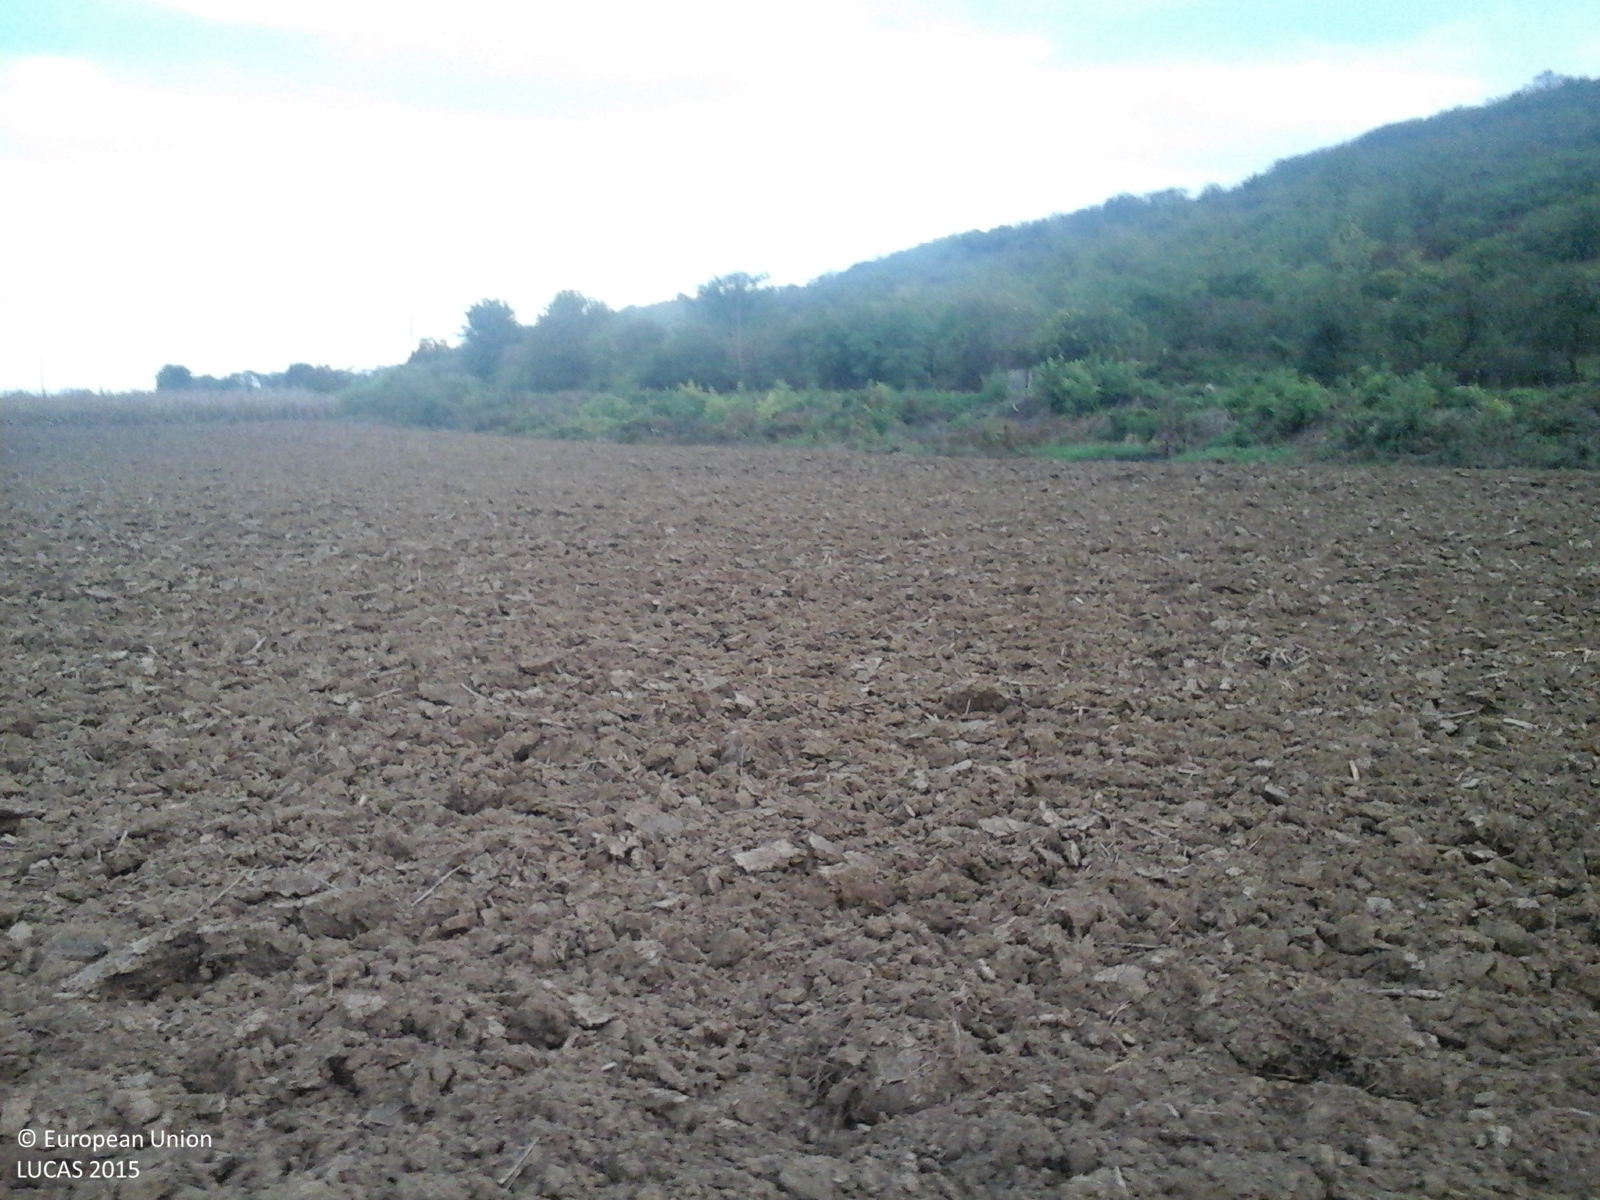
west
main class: Cropland
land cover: Maize
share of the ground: < 10 %
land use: Agriculture (excluding fallow land and kitchen gardens)
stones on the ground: < 10 %
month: October
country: RO
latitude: 45.9608
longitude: 23.3915
